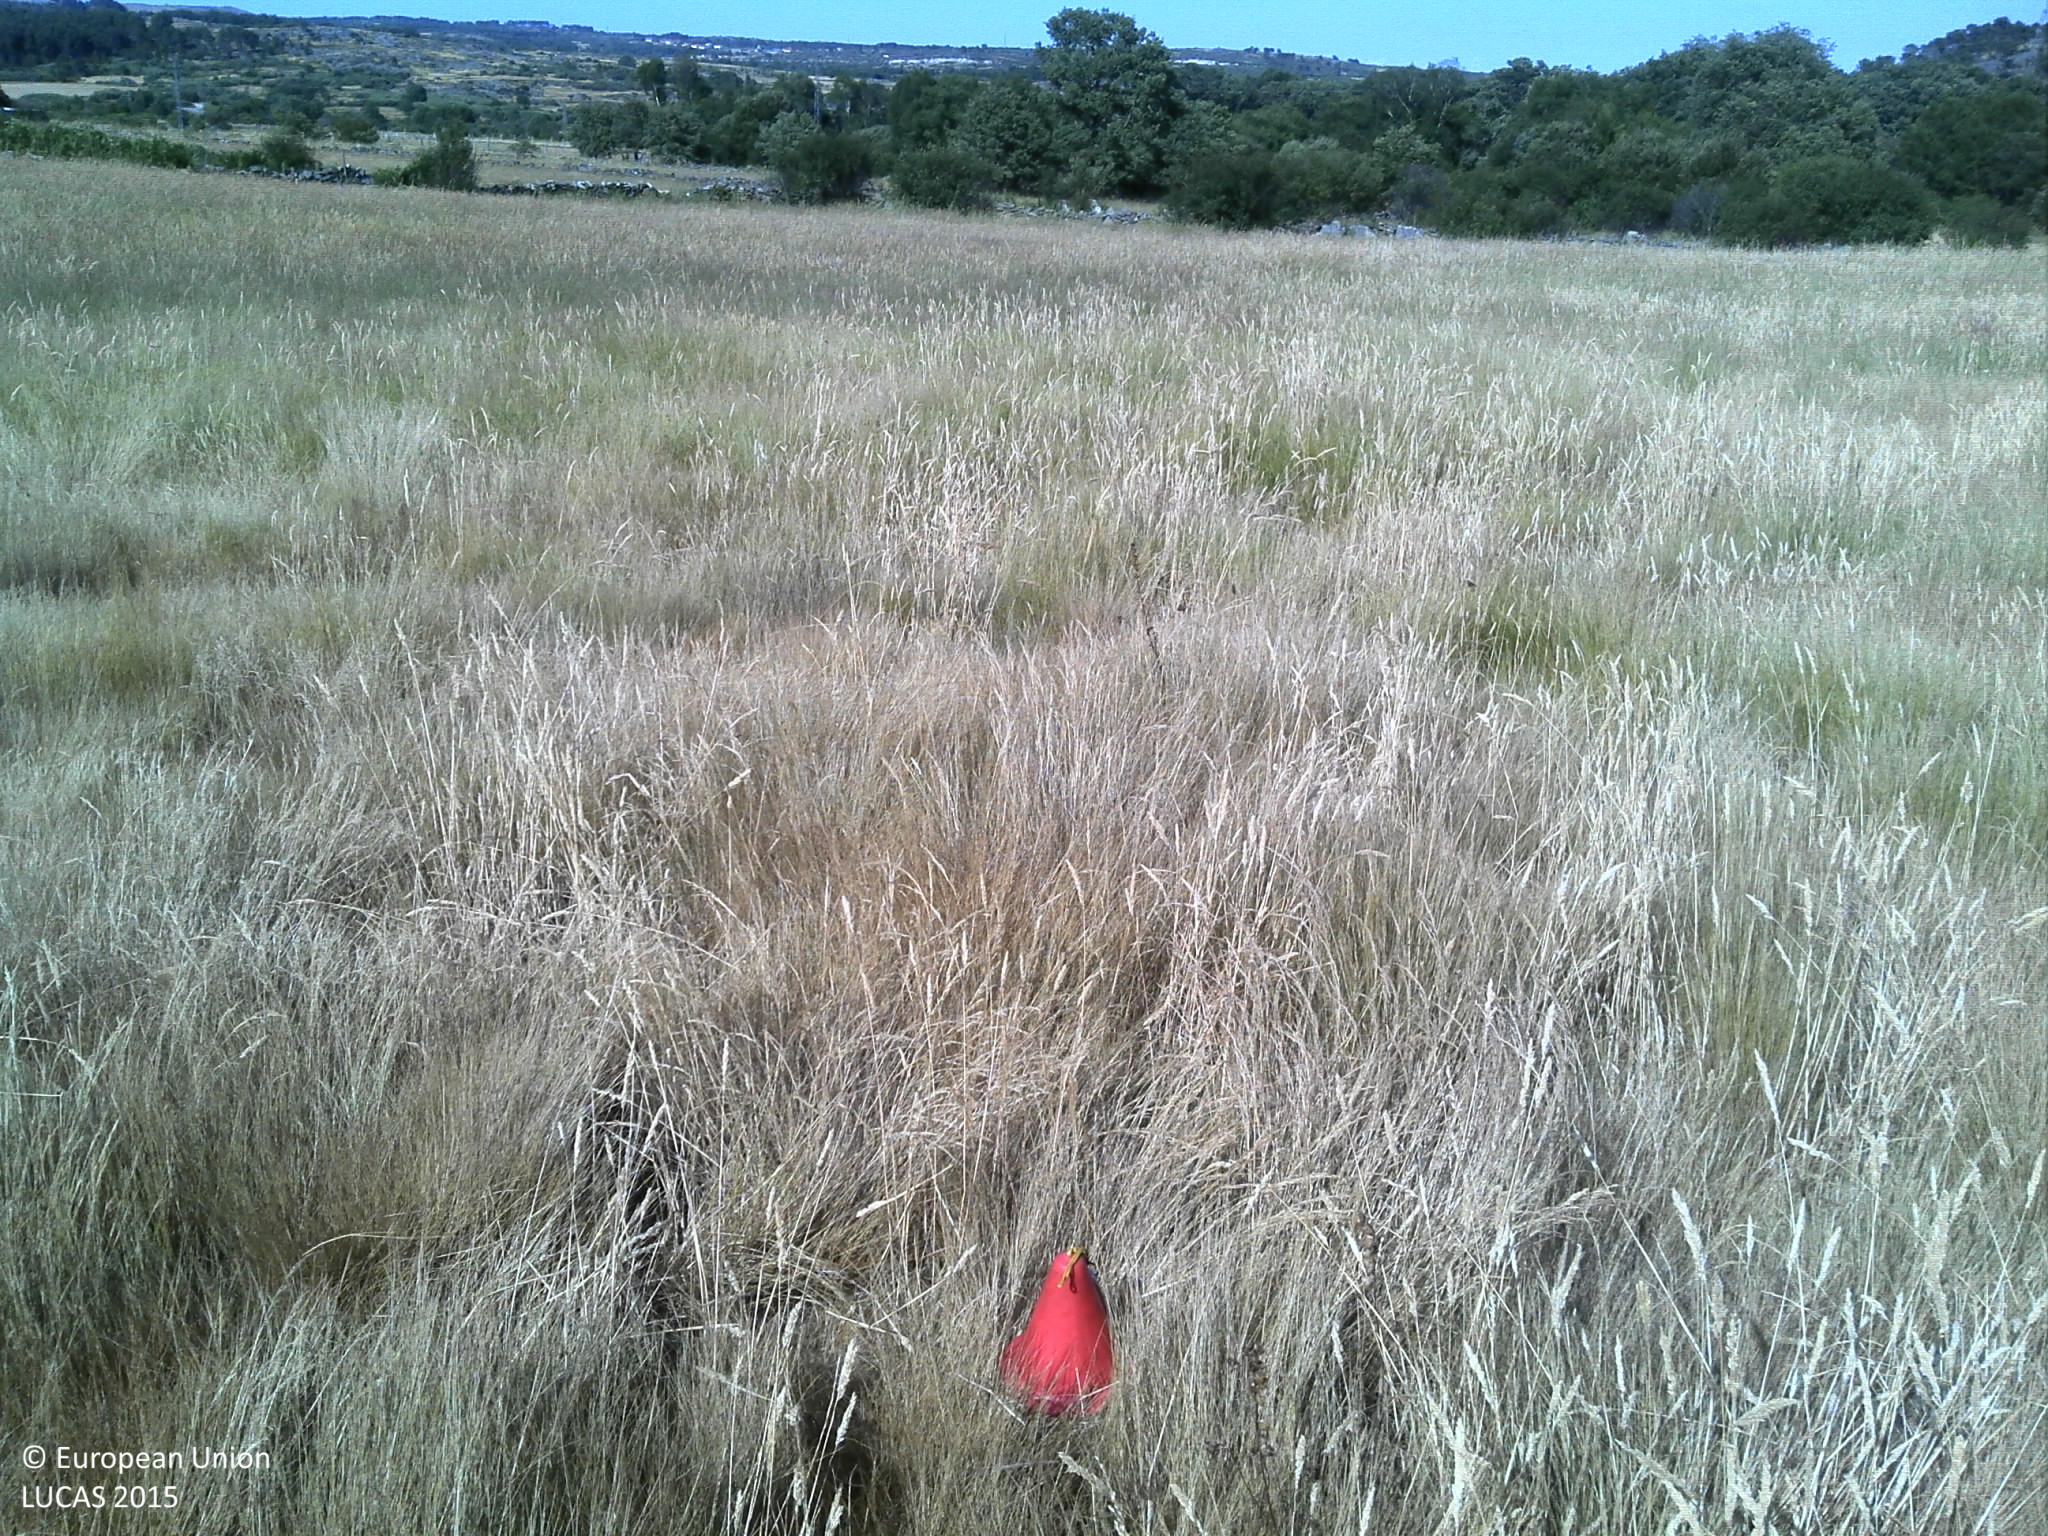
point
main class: Grassland
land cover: Grassland without tree/shrub cover
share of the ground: > 75 %
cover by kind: herbaceous plants 90 %, unconsolidated bare surface 10 %
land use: Agriculture (excluding fallow land and kitchen gardens)
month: July
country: PT
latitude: 41.4816
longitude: -7.7258
